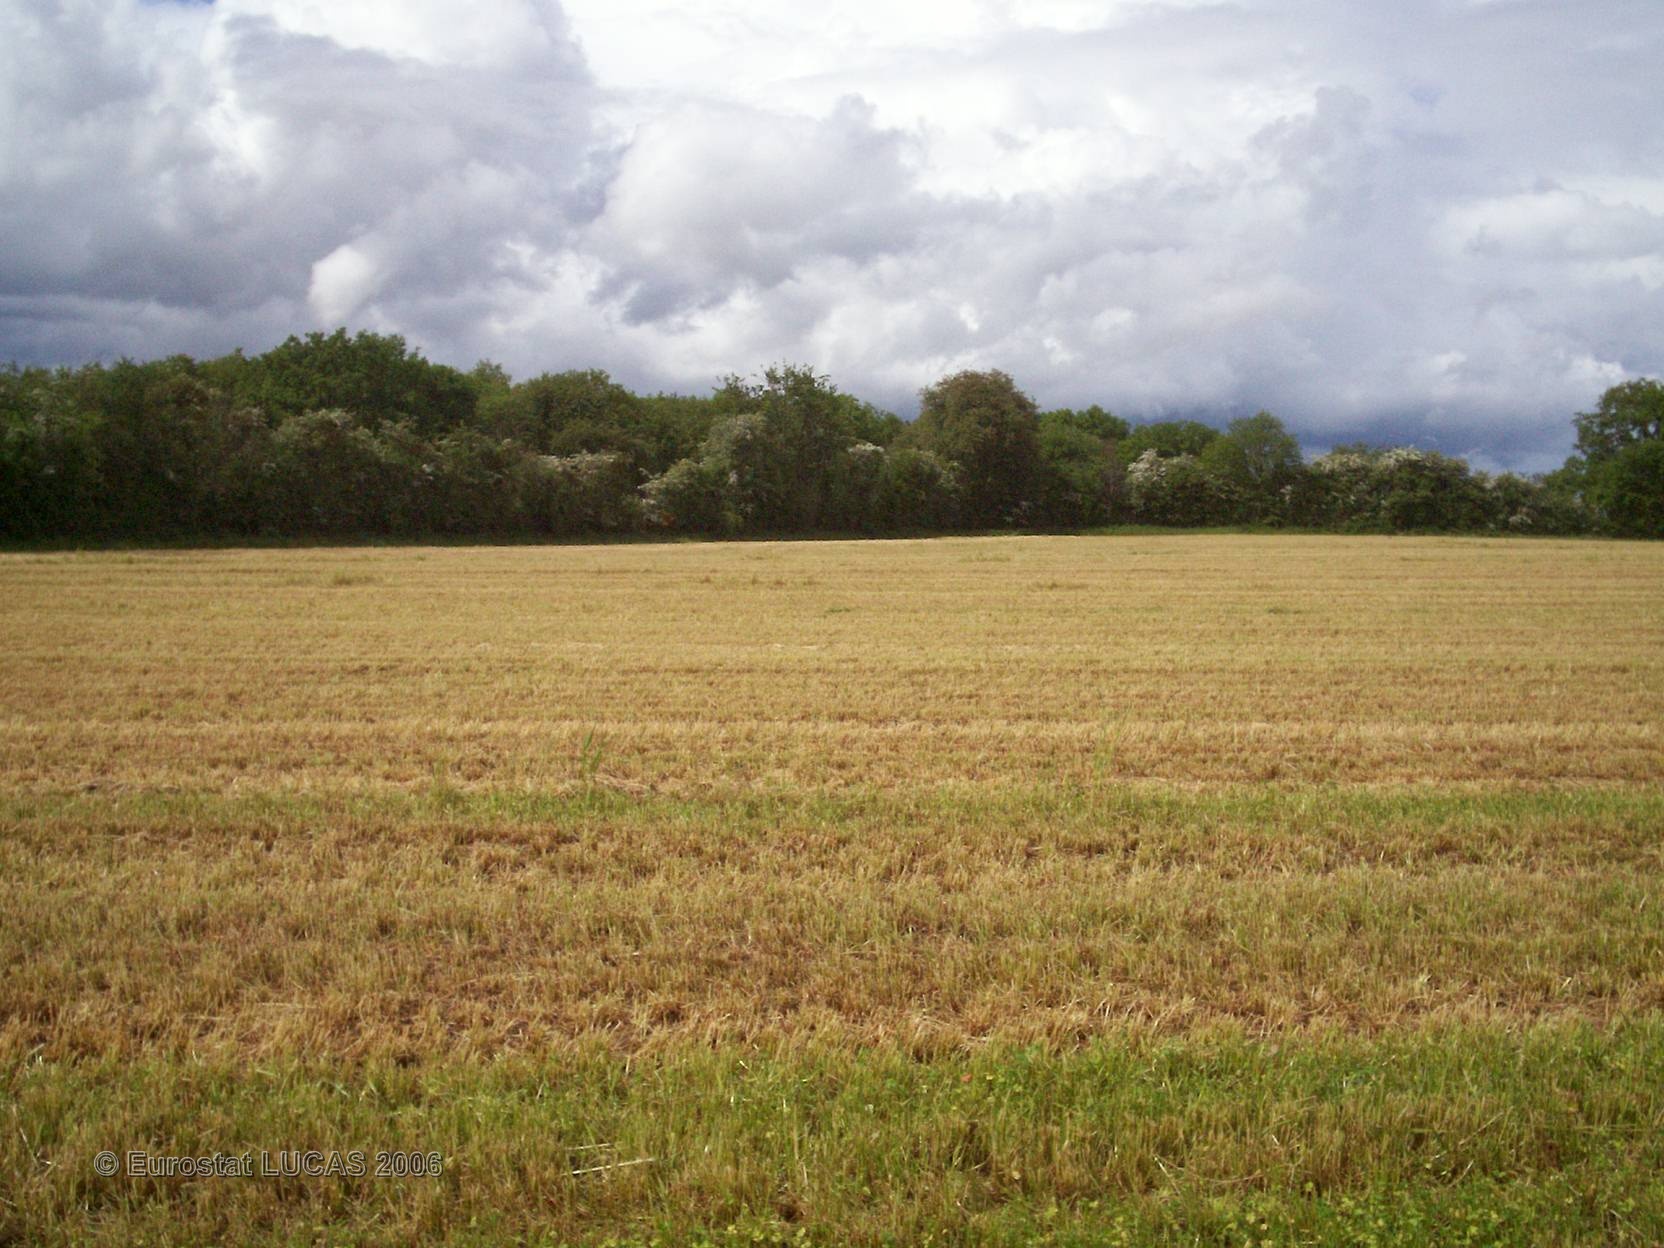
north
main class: Grassland
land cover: Grassland without tree/shrub cover
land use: Agriculture (excluding fallow land and kitchen gardens)
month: May
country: FR
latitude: 46.6173
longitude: -0.2756
